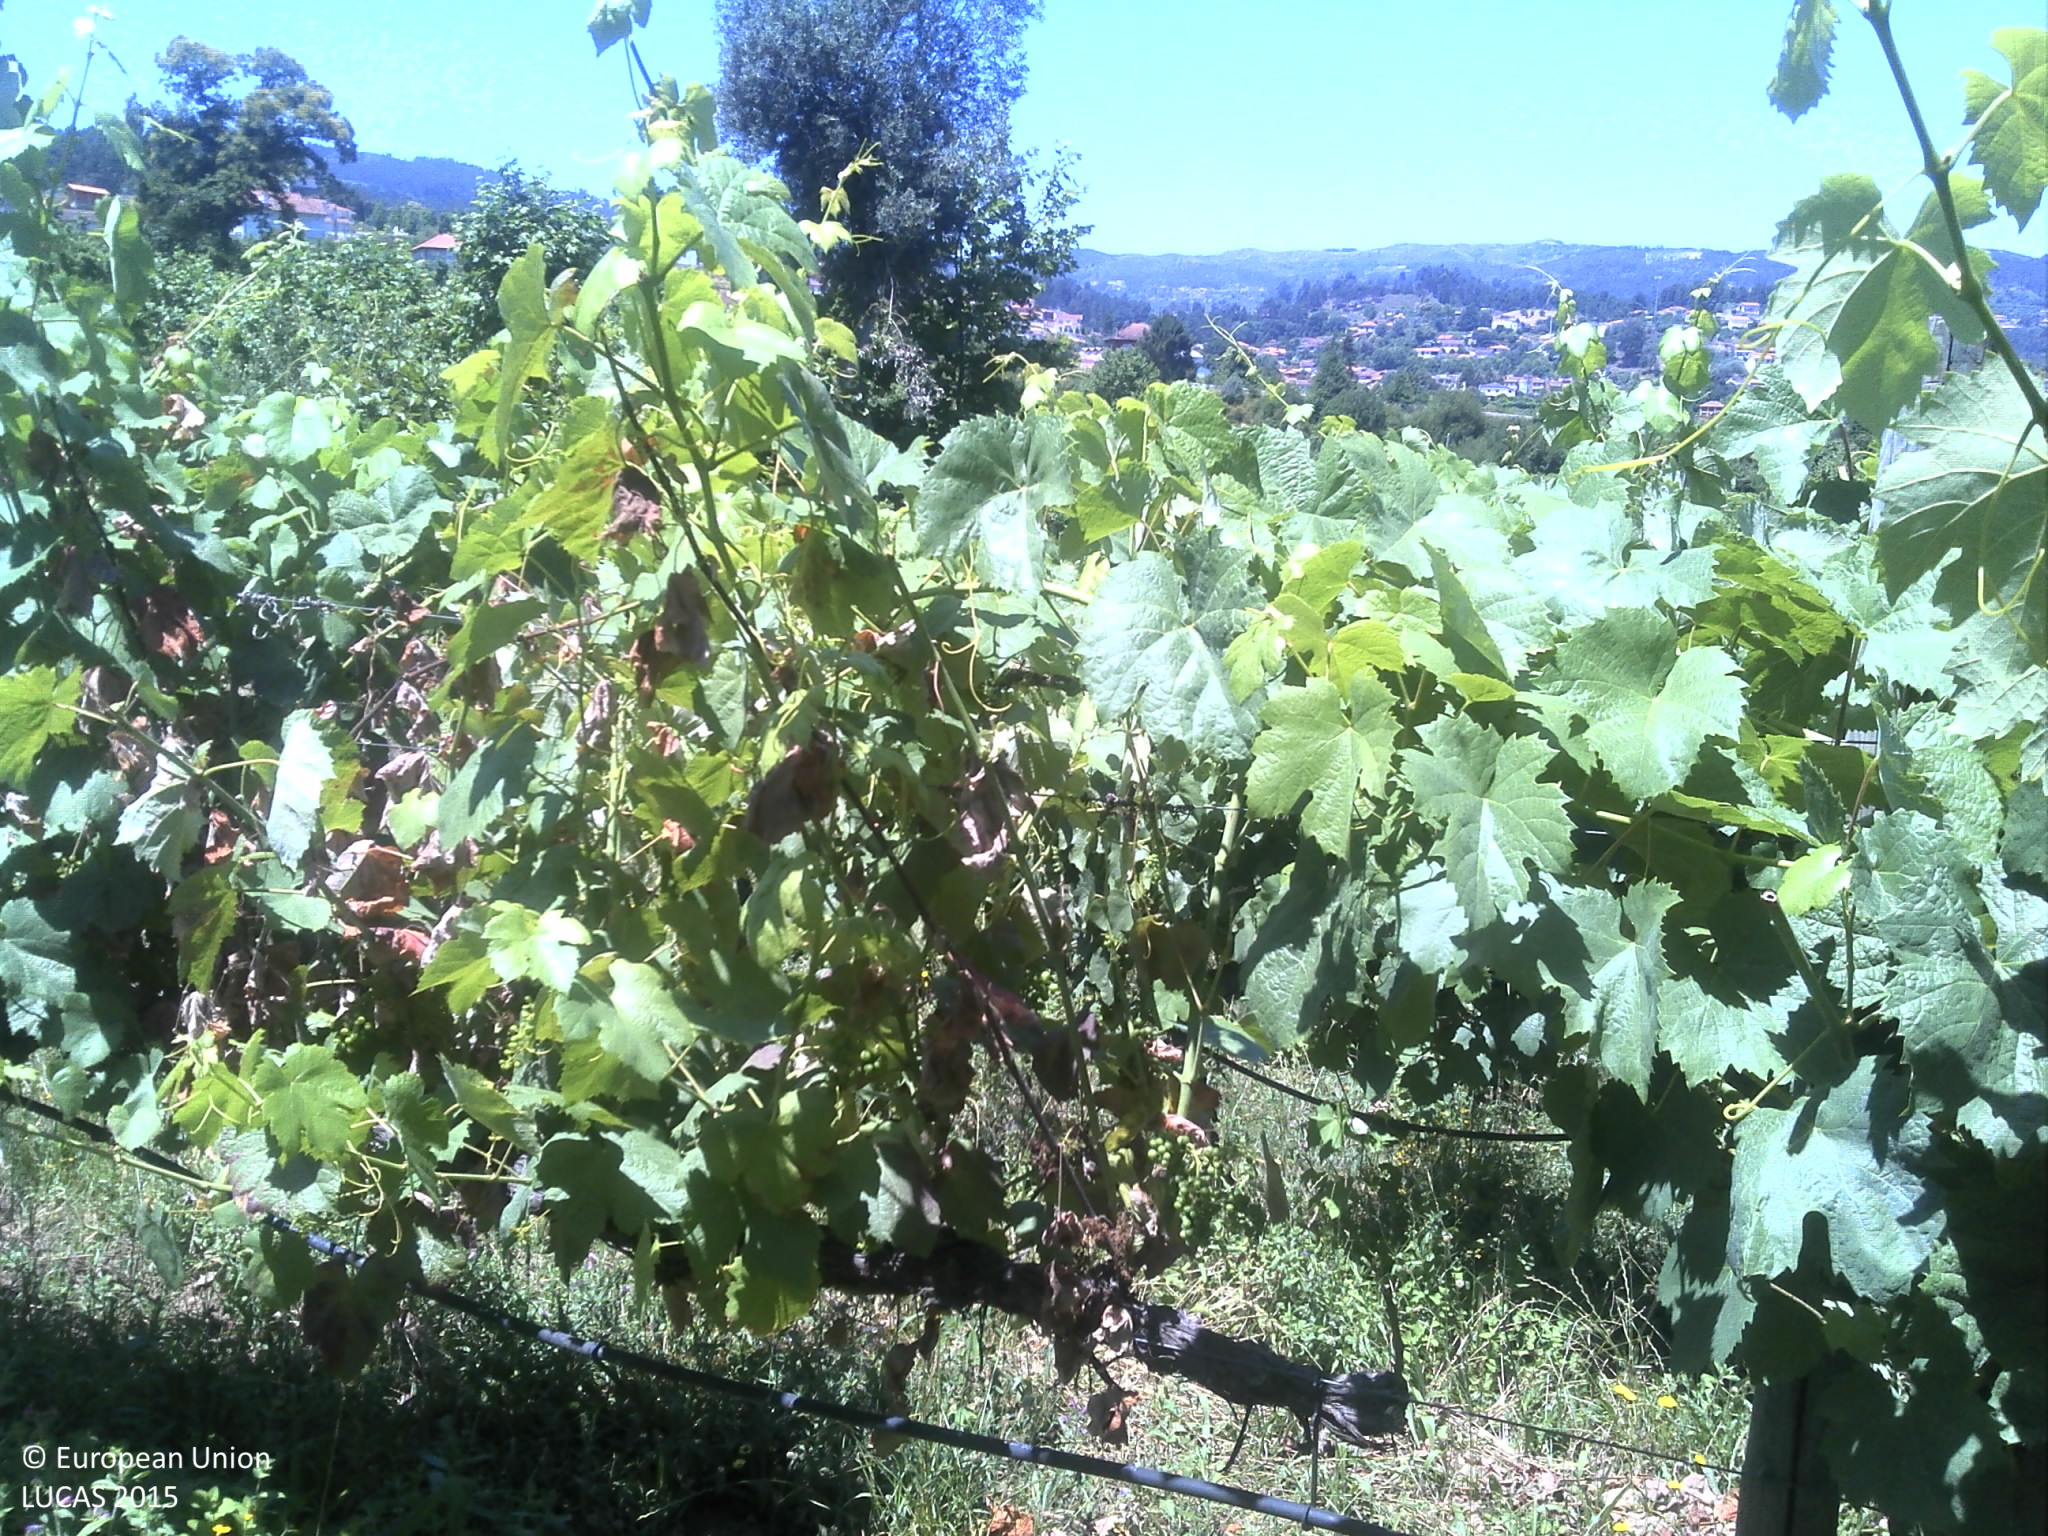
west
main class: Cropland
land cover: Vineyards
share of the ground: 25 - 50 %
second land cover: Grassland without tree/shrub cover
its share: > 75 %
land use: Agriculture (excluding fallow land and kitchen gardens)
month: June
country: PT
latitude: 41.3781
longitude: -7.9905
